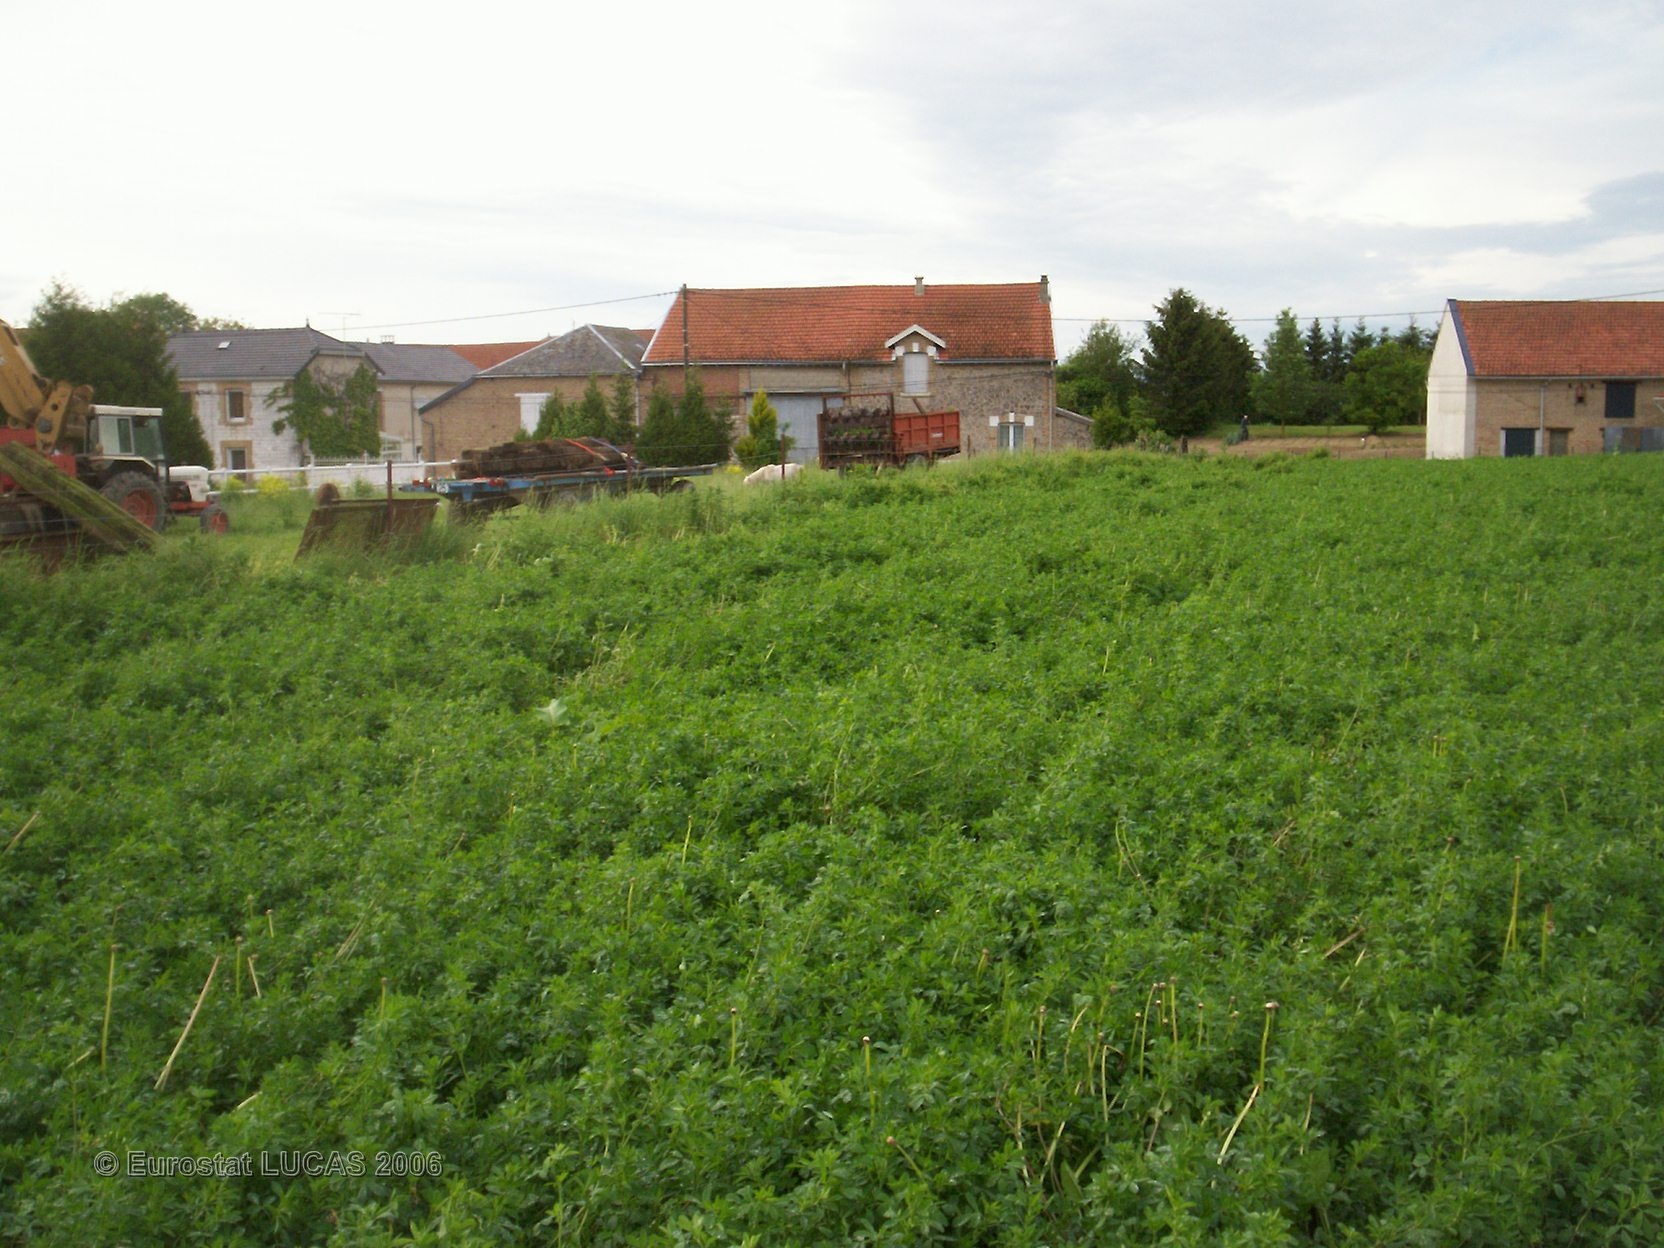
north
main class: Cropland
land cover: Lucerne
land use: Agriculture (excluding fallow land and kitchen gardens)
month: May
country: FR
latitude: 49.4495
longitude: 4.3542
